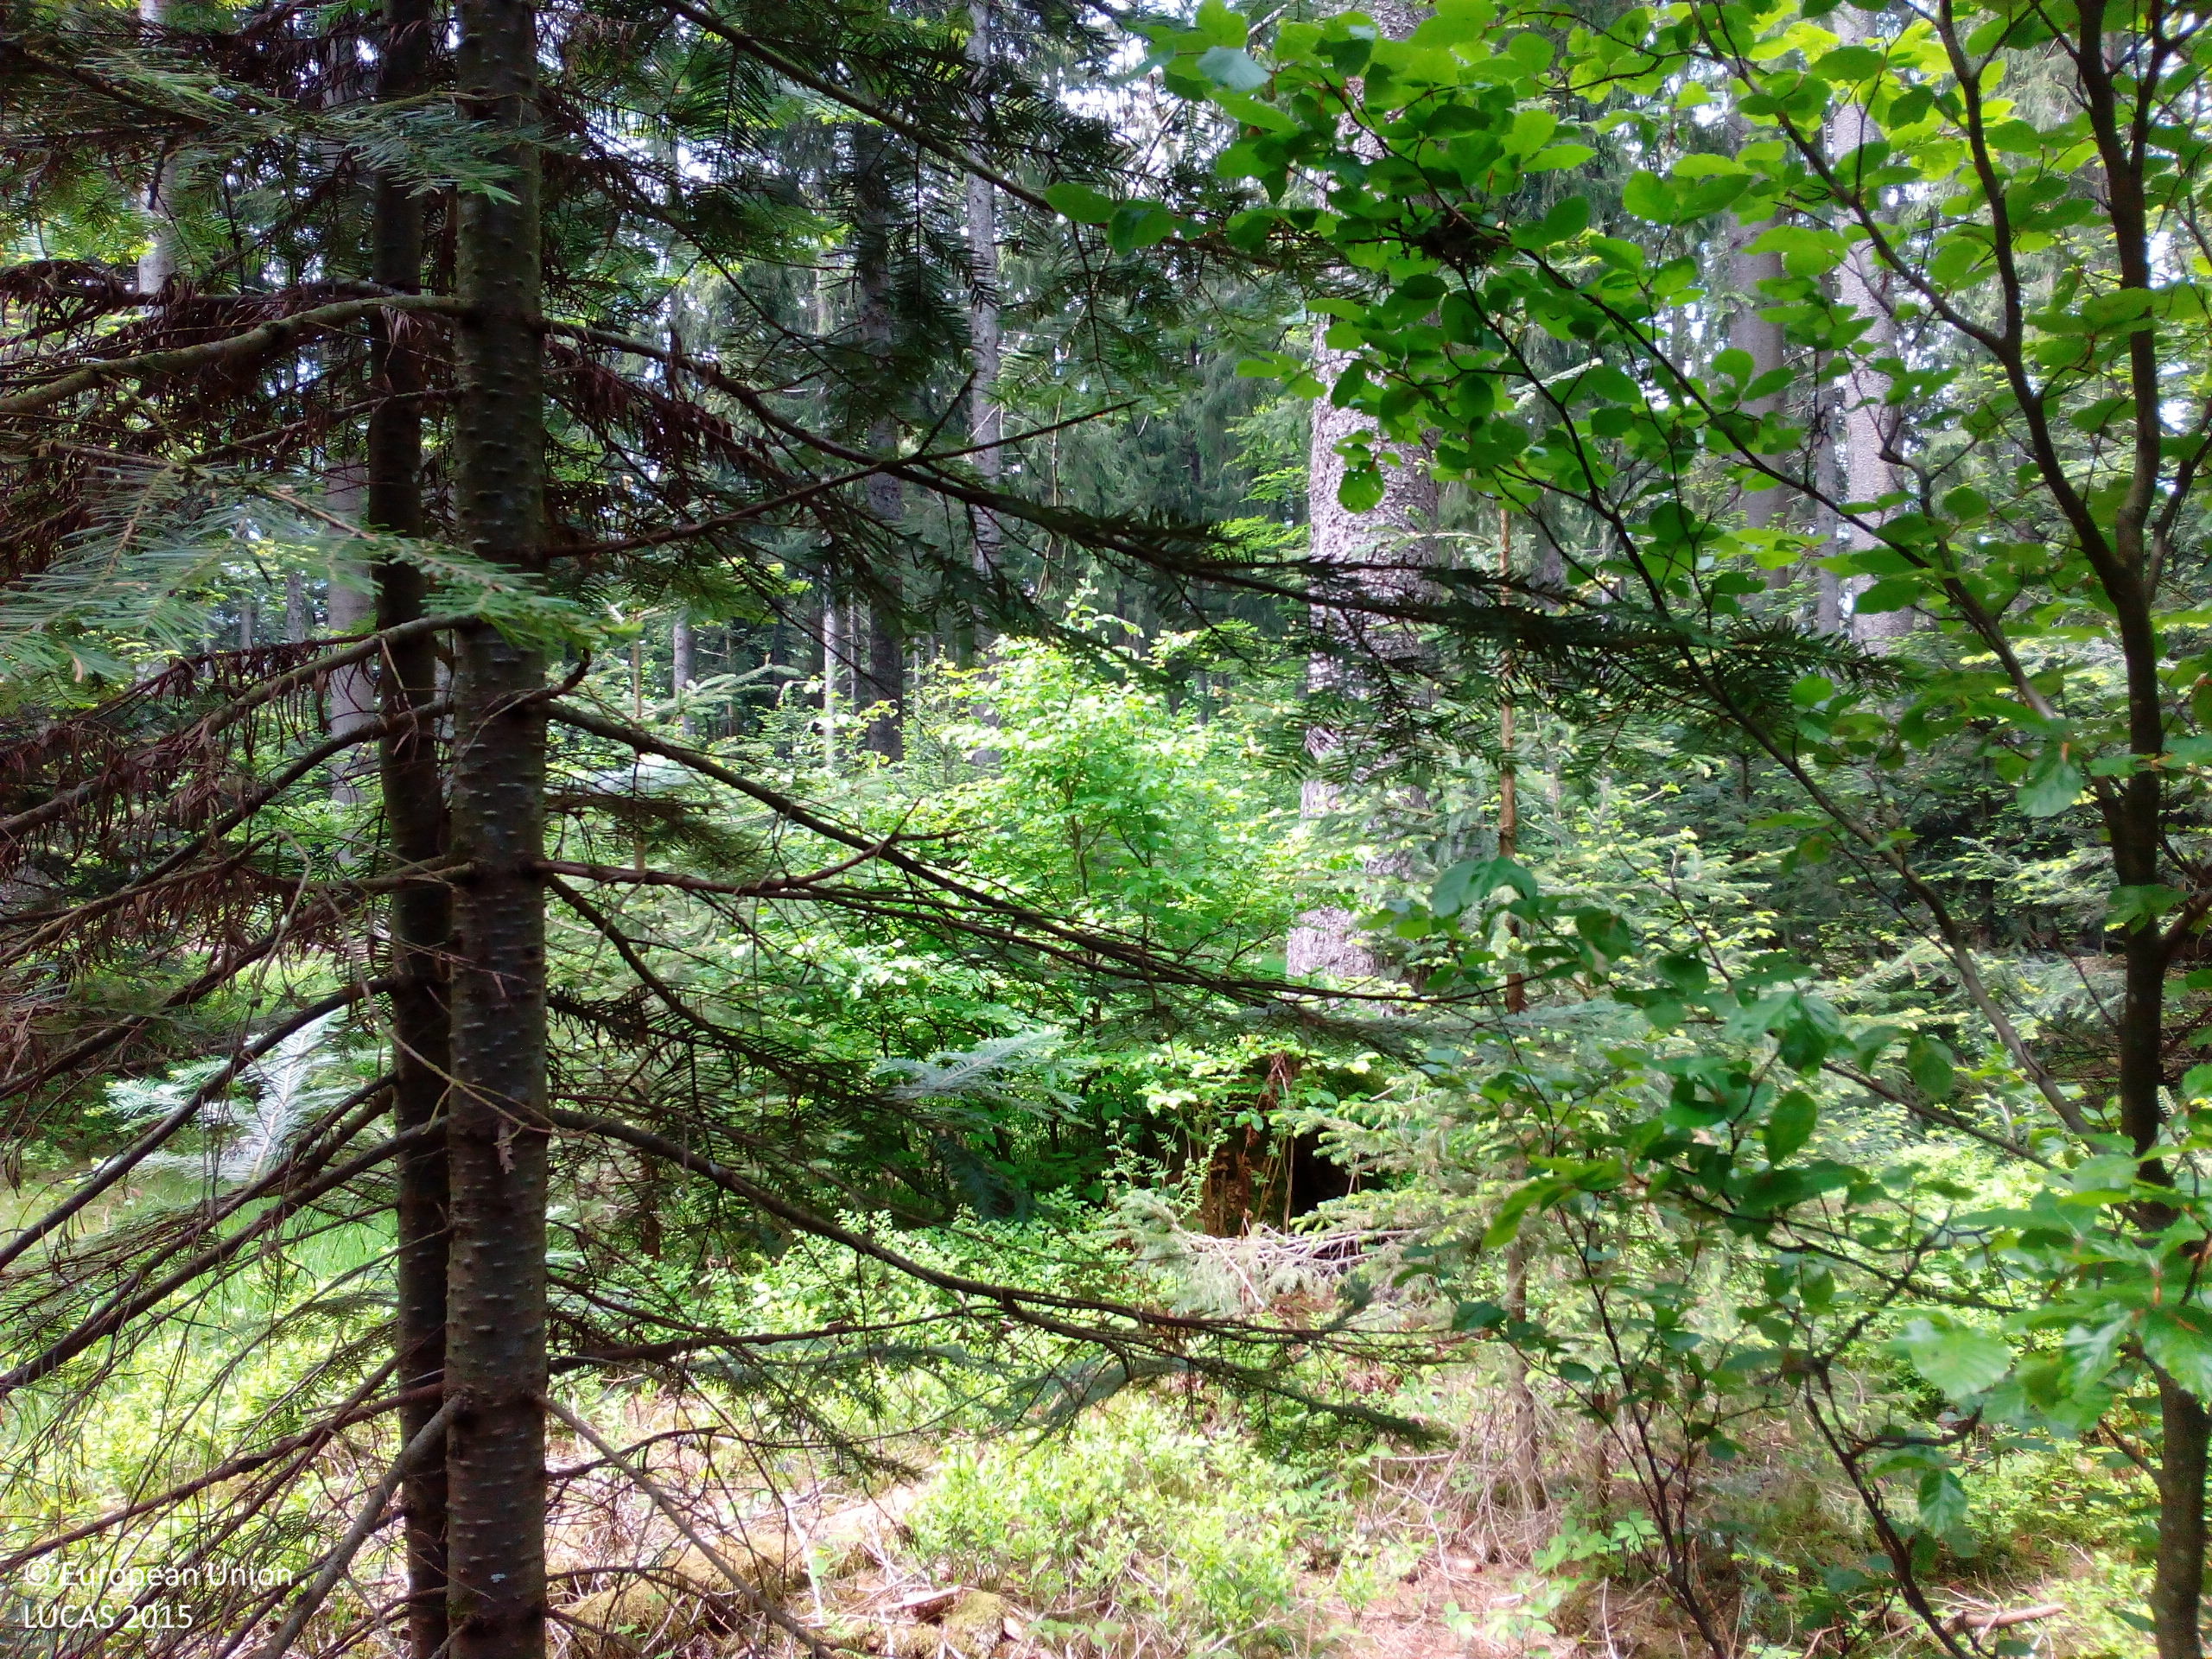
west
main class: Woodland
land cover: Other mixed woodland
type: hemiboreal forest and nemoral coniferous forest and mixed broadleaved-coniferous forest
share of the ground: > 75 %
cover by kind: coniferous forest trees 70 %, broadleaved forest trees 30 %
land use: Forestry
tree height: > 5 m
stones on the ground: < 10 %
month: May
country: DE
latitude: 47.9918
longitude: 8.1384
